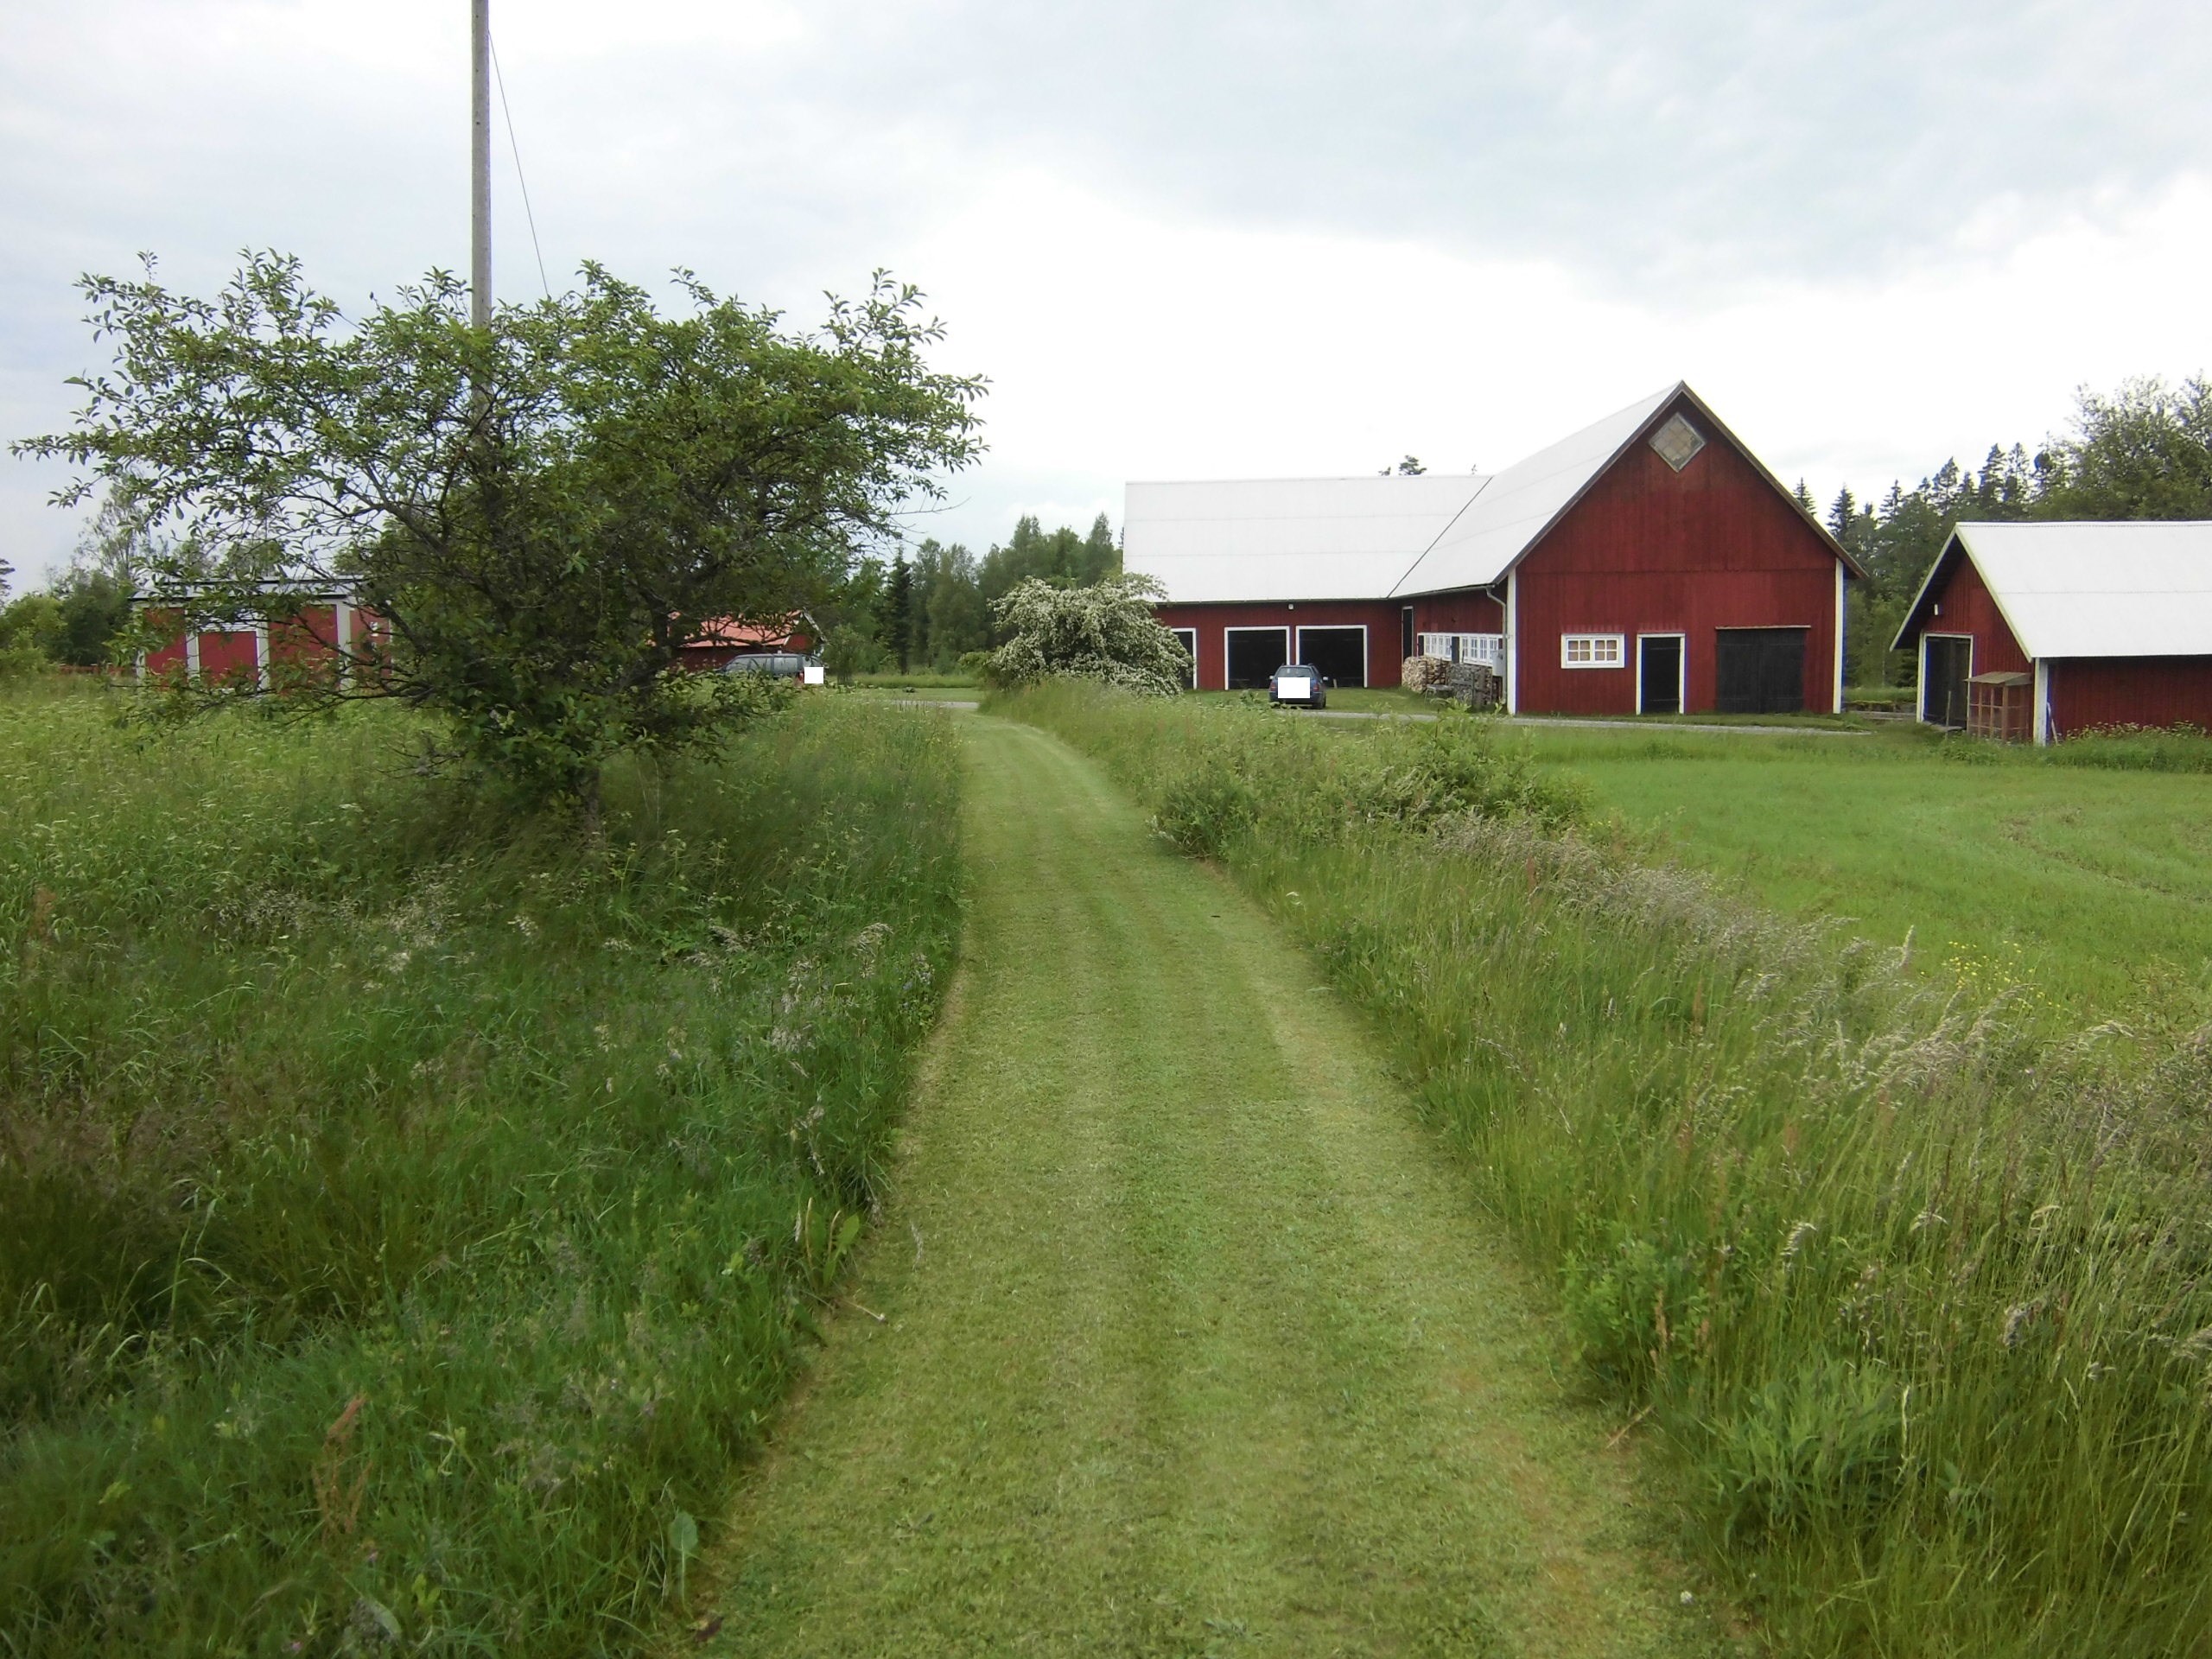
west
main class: Grassland
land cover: Grassland without tree/shrub cover
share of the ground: > 75 %
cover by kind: herbaceous plants 100 %
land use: Agriculture (excluding fallow land and kitchen gardens)
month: June
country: SE
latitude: 57.0409
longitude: 14.6278
